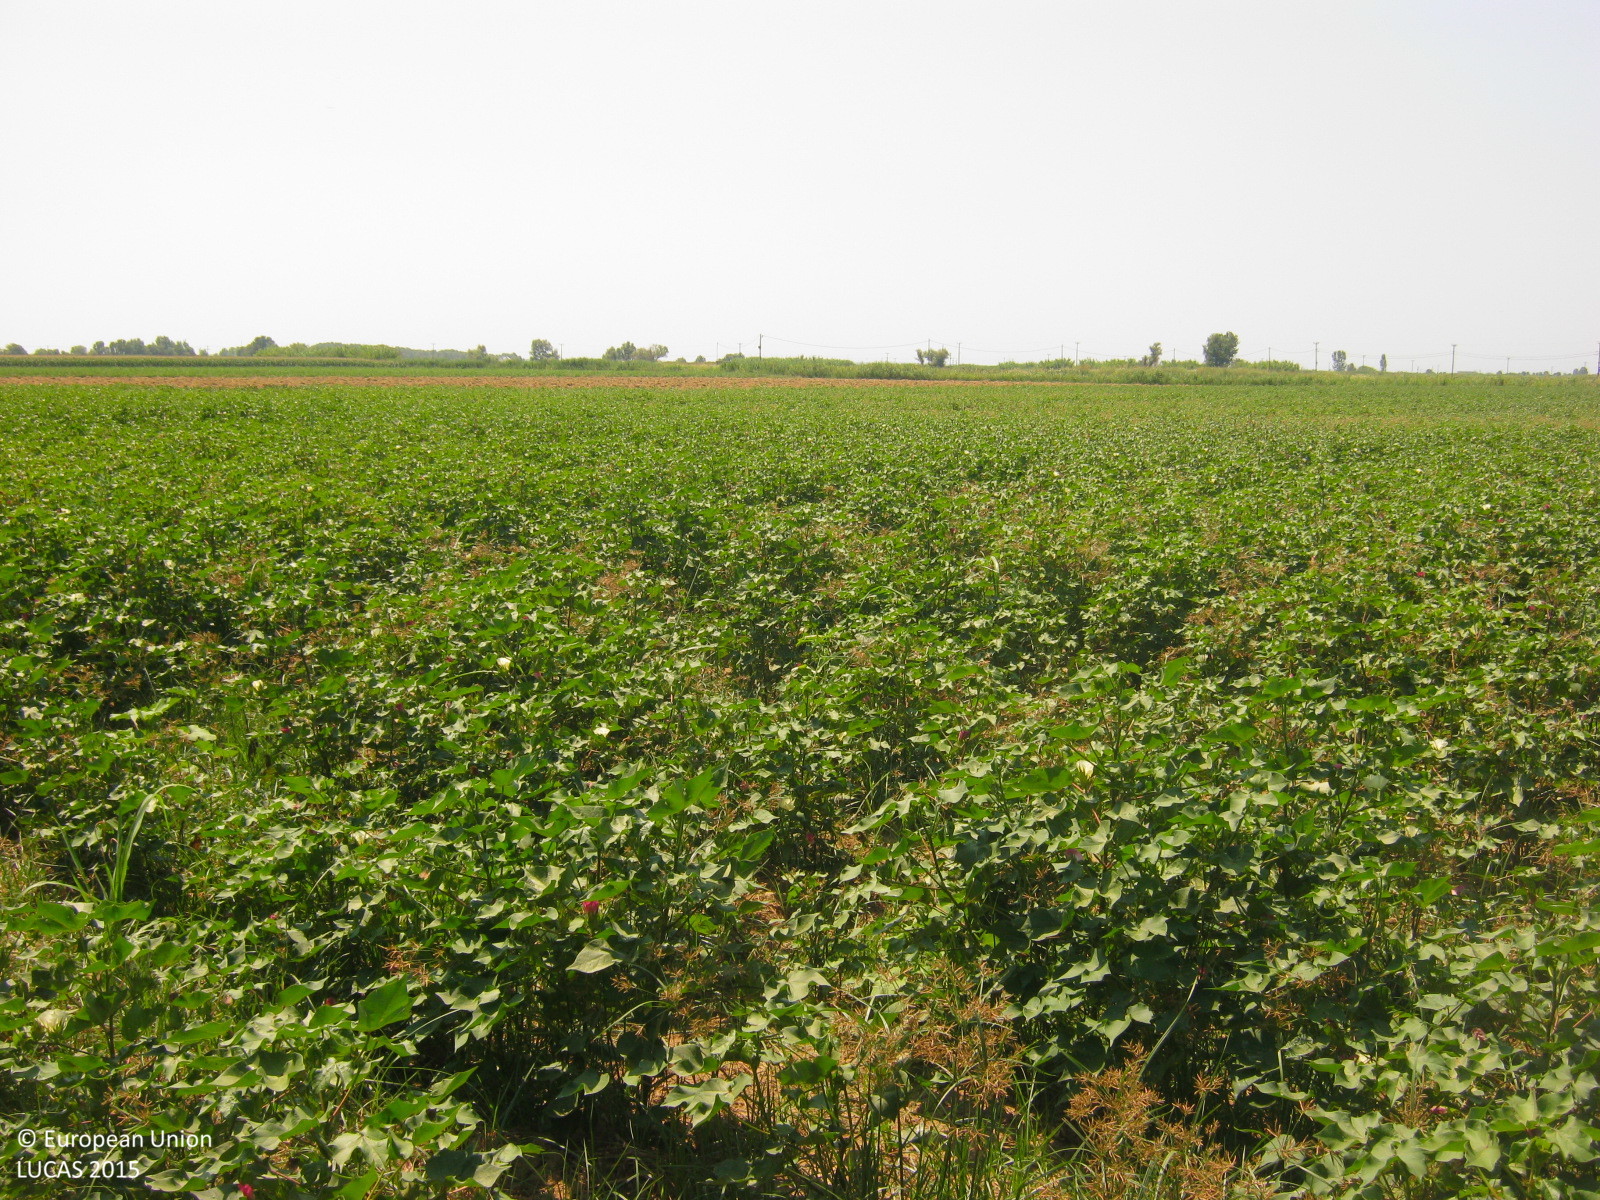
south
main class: Cropland
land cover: Cotton
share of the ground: > 75 %
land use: Agriculture (excluding fallow land and kitchen gardens)
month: July
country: GR
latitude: 41.0633
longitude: 25.1702
